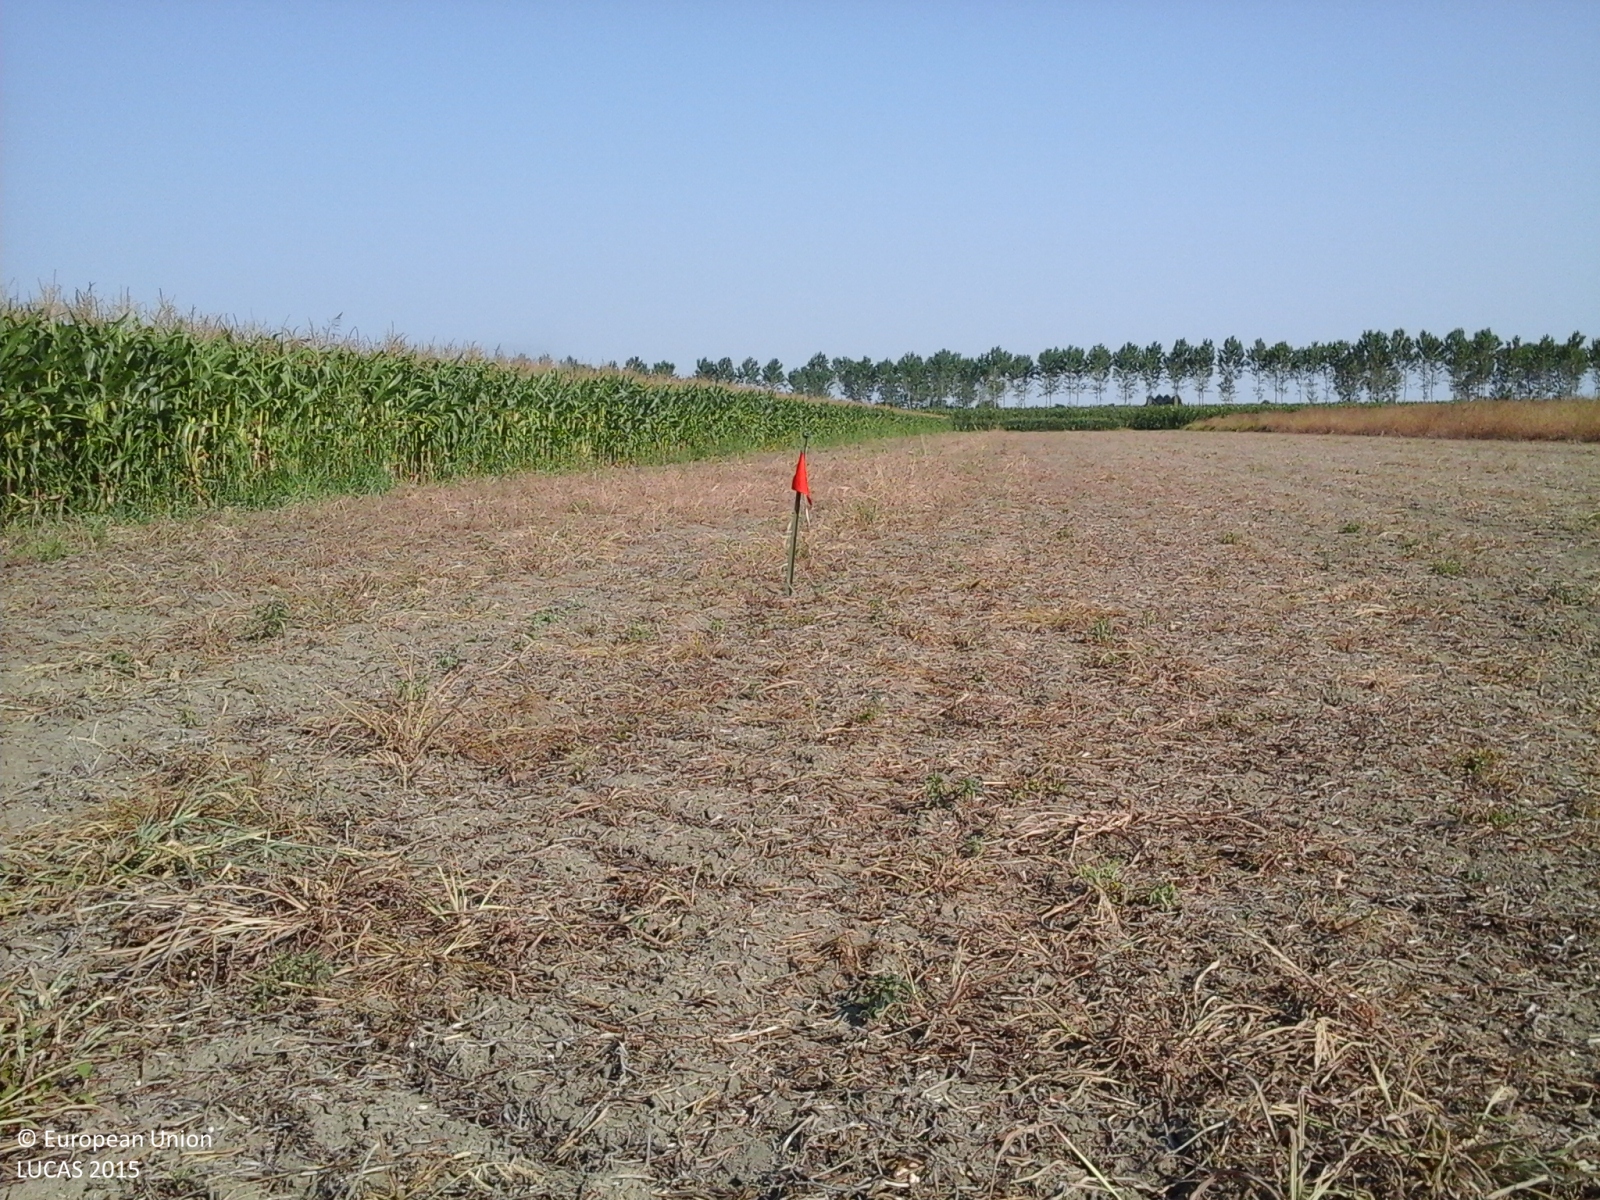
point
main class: Cropland
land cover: Dry pulses
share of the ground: > 75 %
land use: Agriculture (excluding fallow land and kitchen gardens)
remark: Harvested field
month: July
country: IT
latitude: 44.5708
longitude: 11.7215
